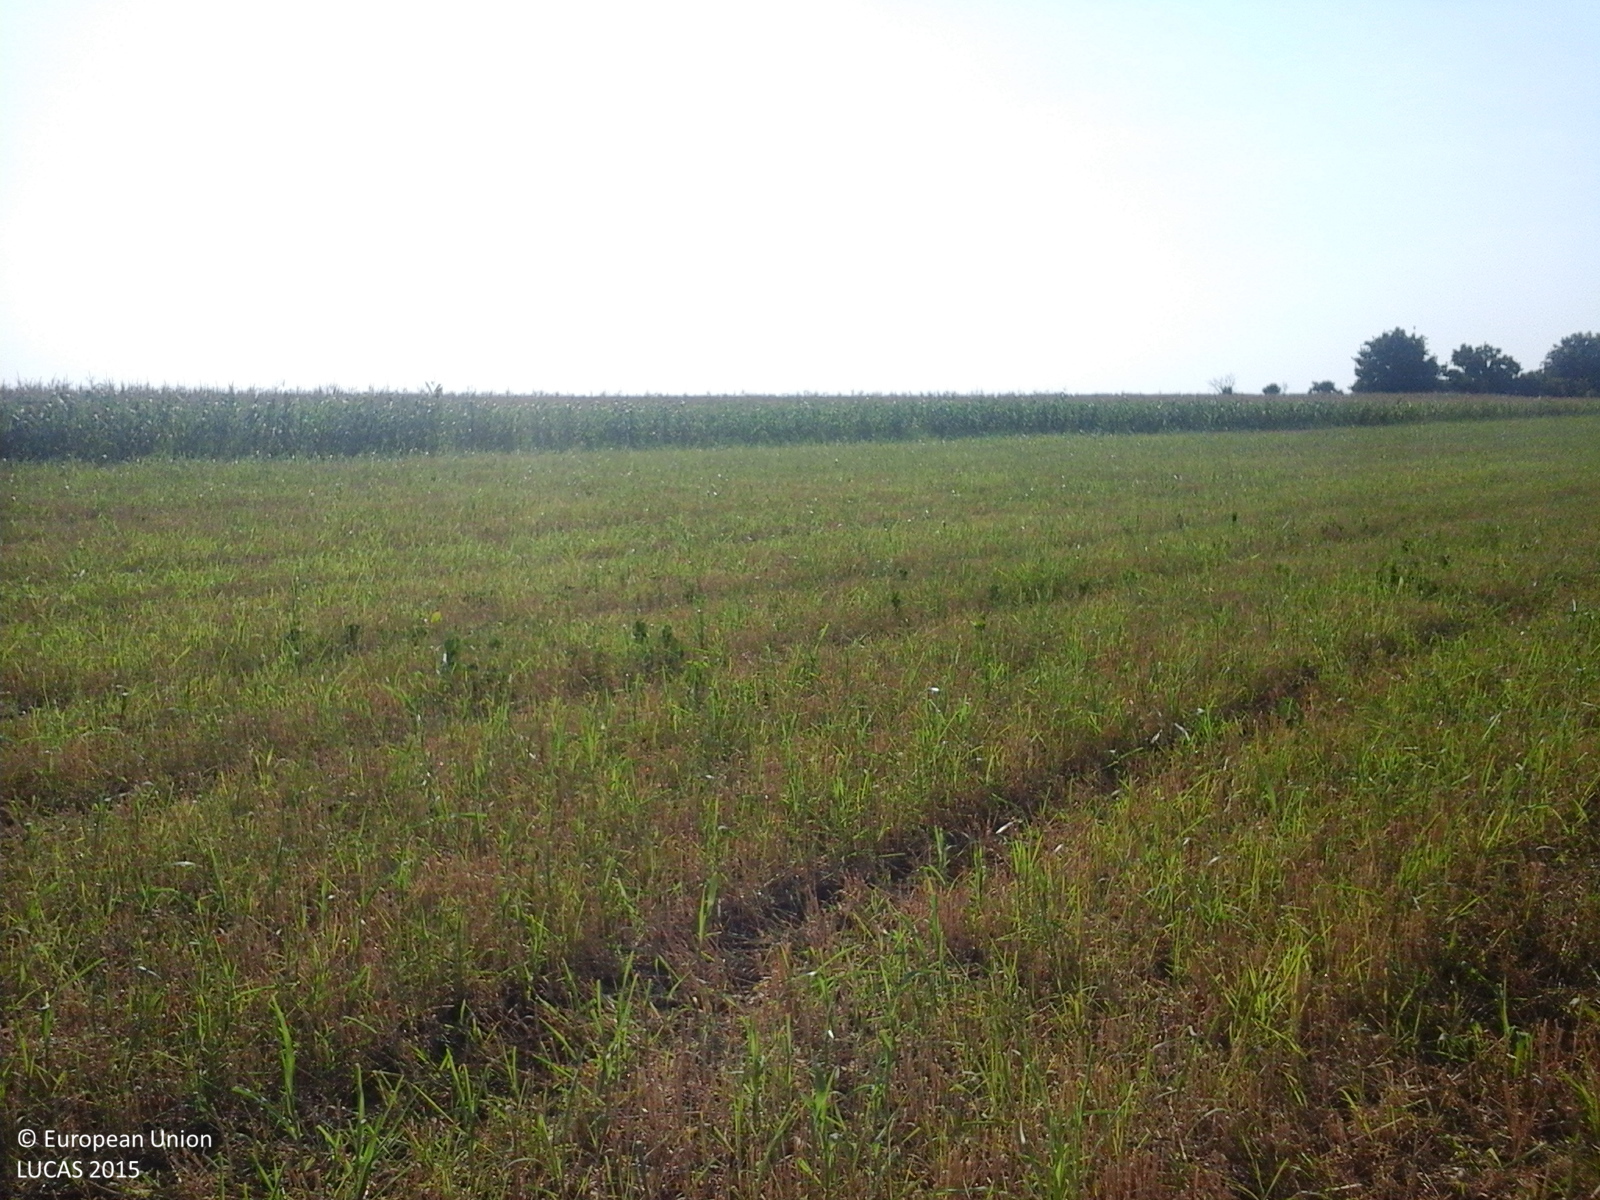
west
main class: Cropland
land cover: Common wheat
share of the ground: 25 - 50 %
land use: Agriculture (excluding fallow land and kitchen gardens)
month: July
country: RO
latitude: 44.9215
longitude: 26.5525
